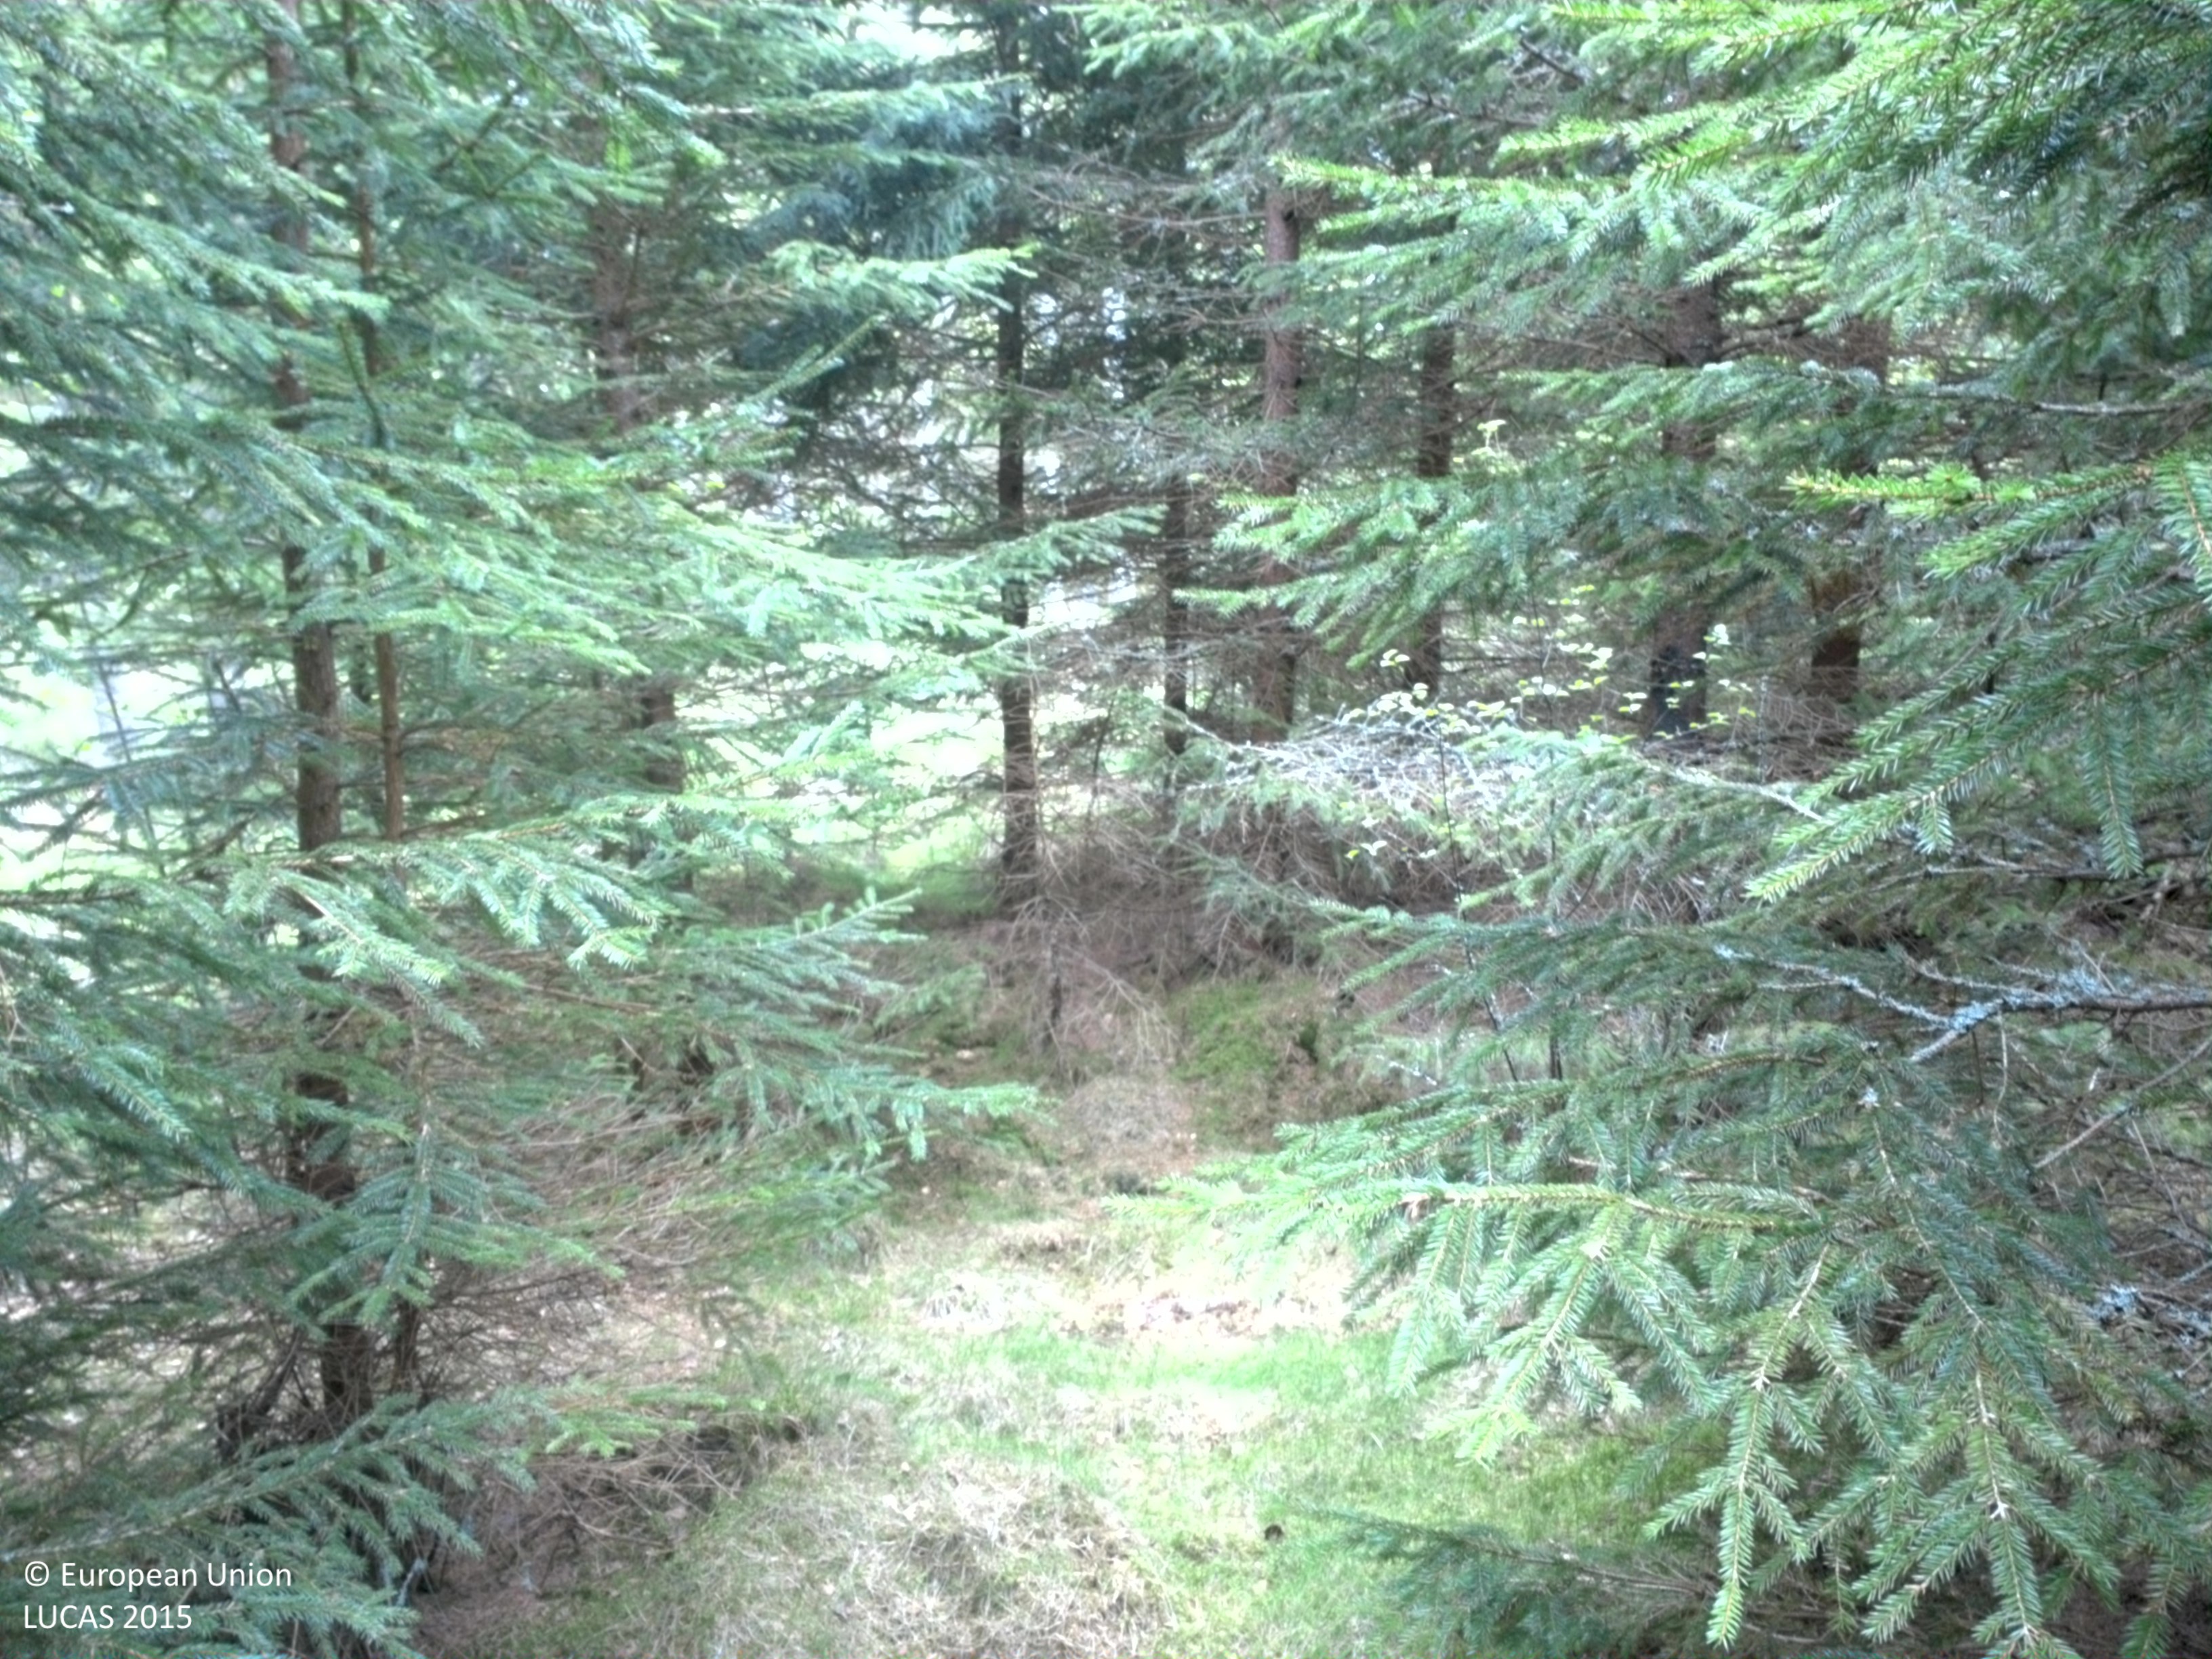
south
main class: Woodland
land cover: Spruce dominated coniferous woodland
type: boreal forest
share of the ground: > 75 %
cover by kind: coniferous forest trees 85 %, lichens and mosses 10 %, herbaceous plants 5 %
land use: Forestry
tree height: > 5 m
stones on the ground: < 10 %
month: May
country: SE
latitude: 56.6244
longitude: 15.1648
